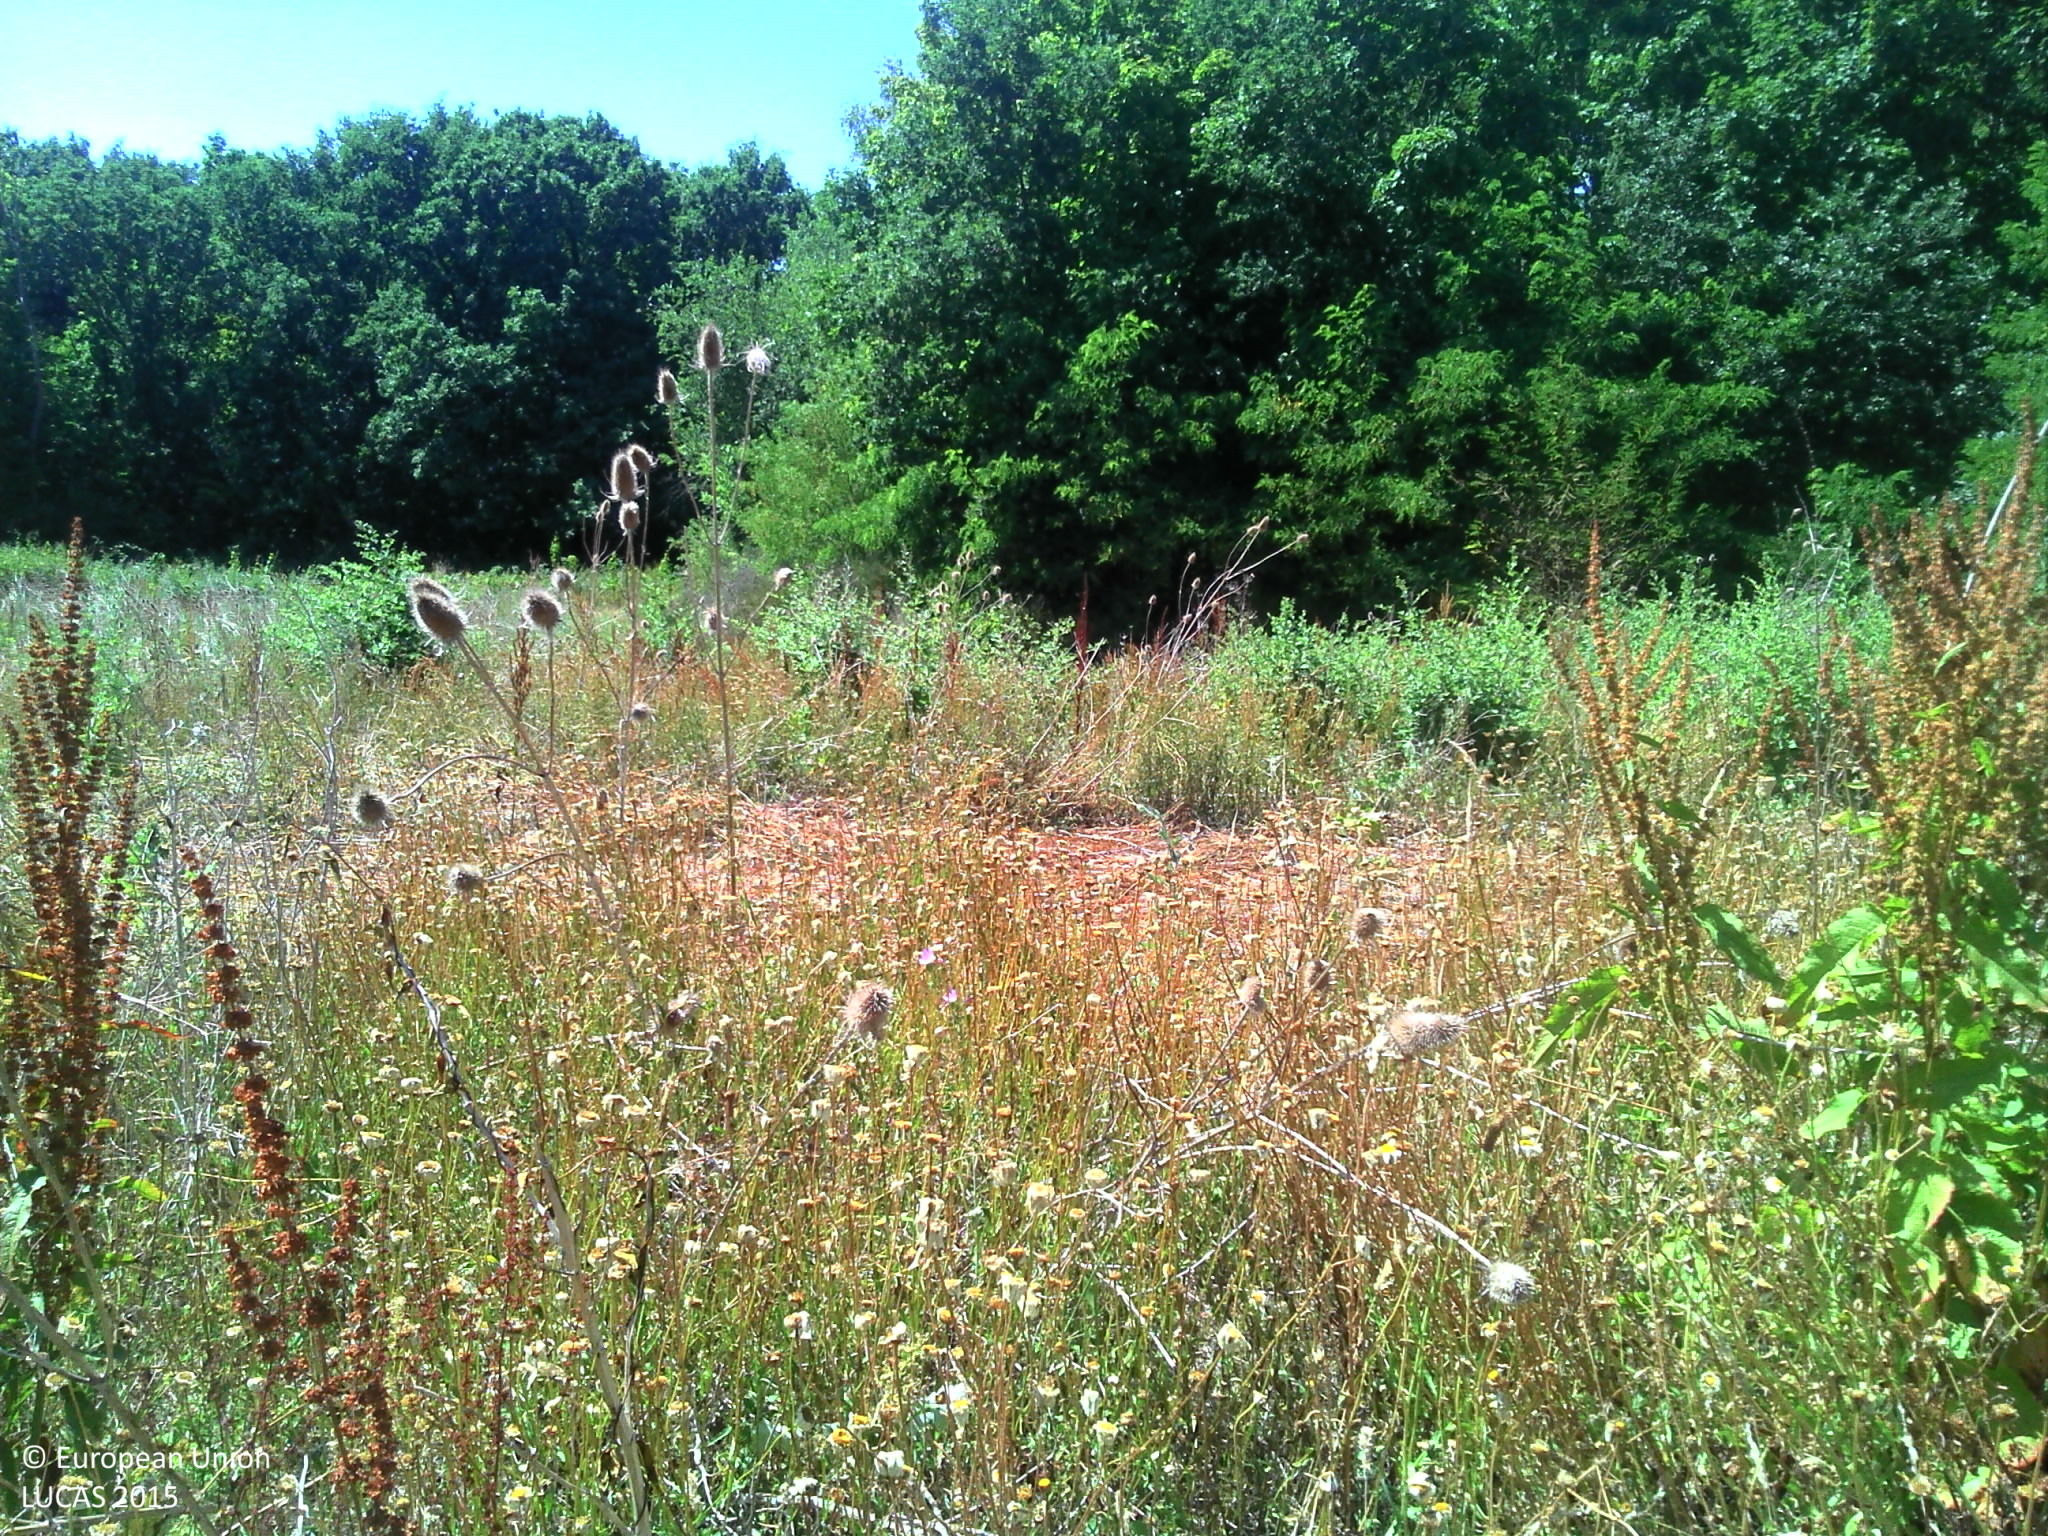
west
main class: Grassland
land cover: Spontaneously vegetated surfaces
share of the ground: > 75 %
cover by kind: herbaceous plants 80 %, consolidated bare surface 20 %
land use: Abandoned areas
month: July
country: FR
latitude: 49.2330
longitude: 1.2595
